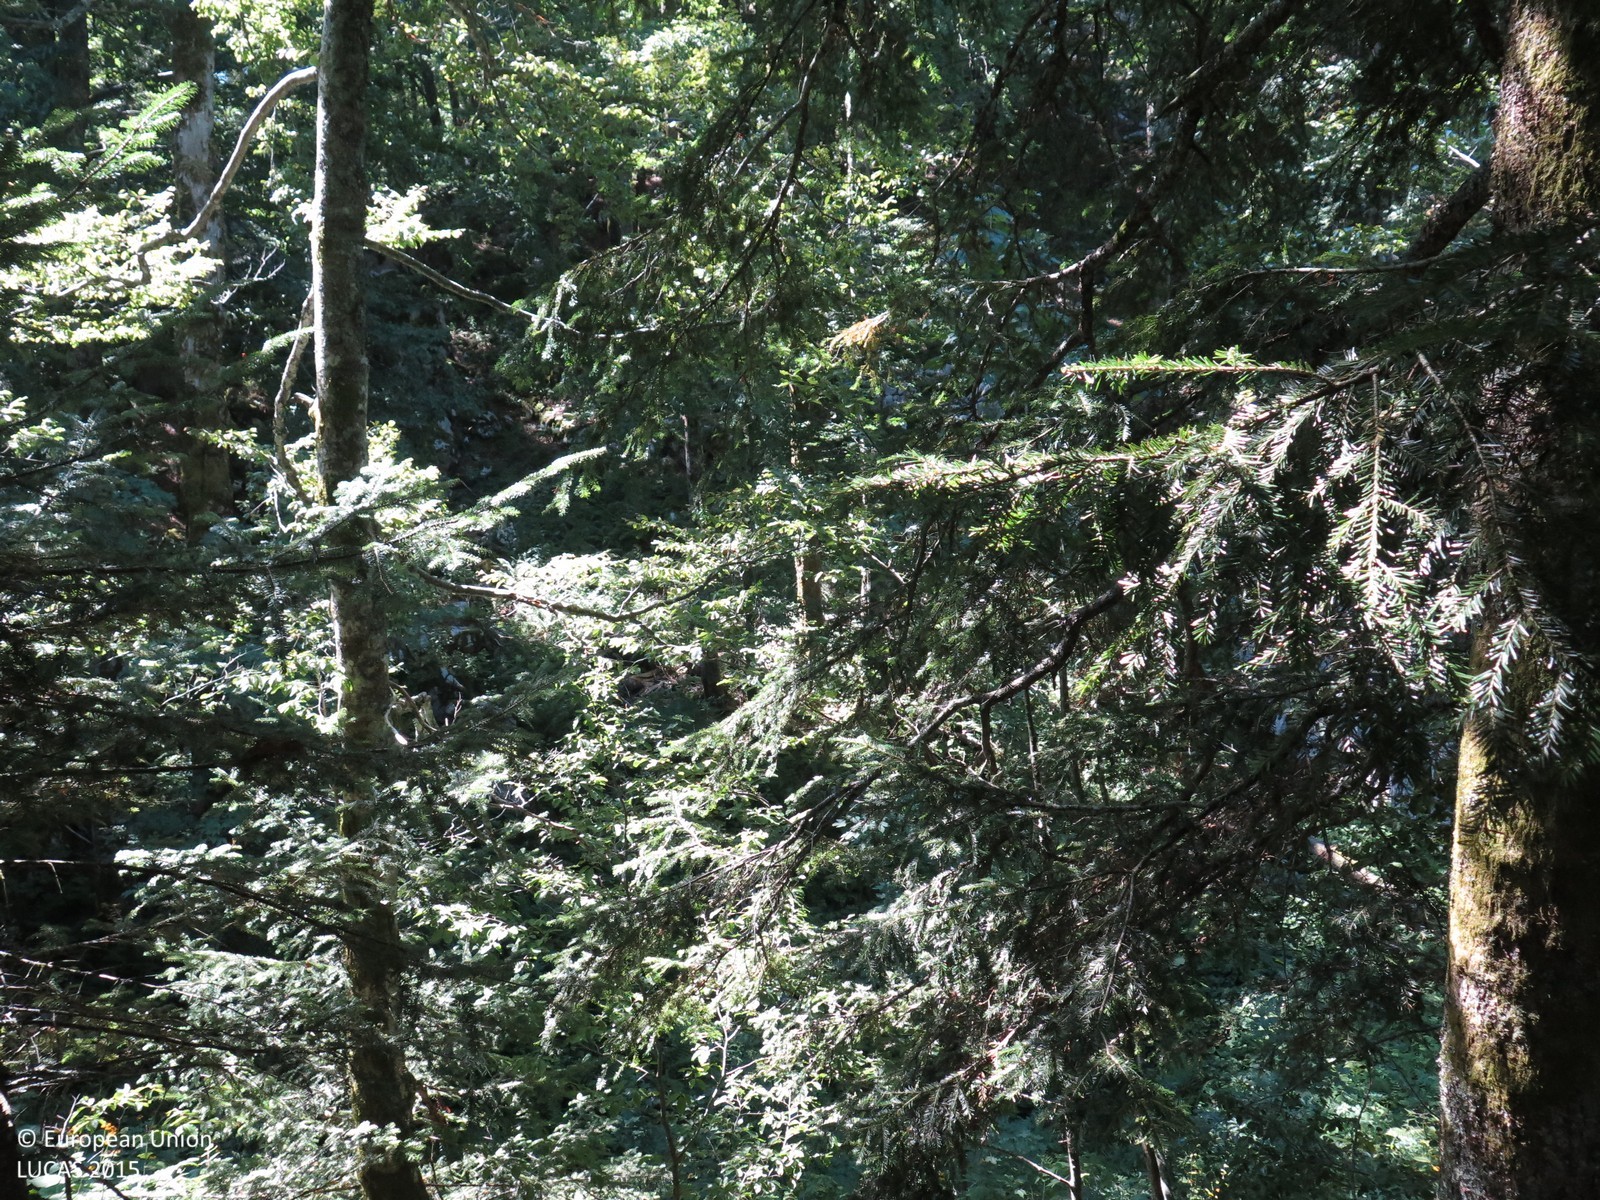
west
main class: Woodland
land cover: Other mixed woodland
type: mountainous beech forest
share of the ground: > 75 %
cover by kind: coniferous forest trees 75 %, broadleaved forest trees 25 %
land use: Forestry
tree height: > 5 m
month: August
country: HR
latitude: 45.2486
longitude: 14.8493
